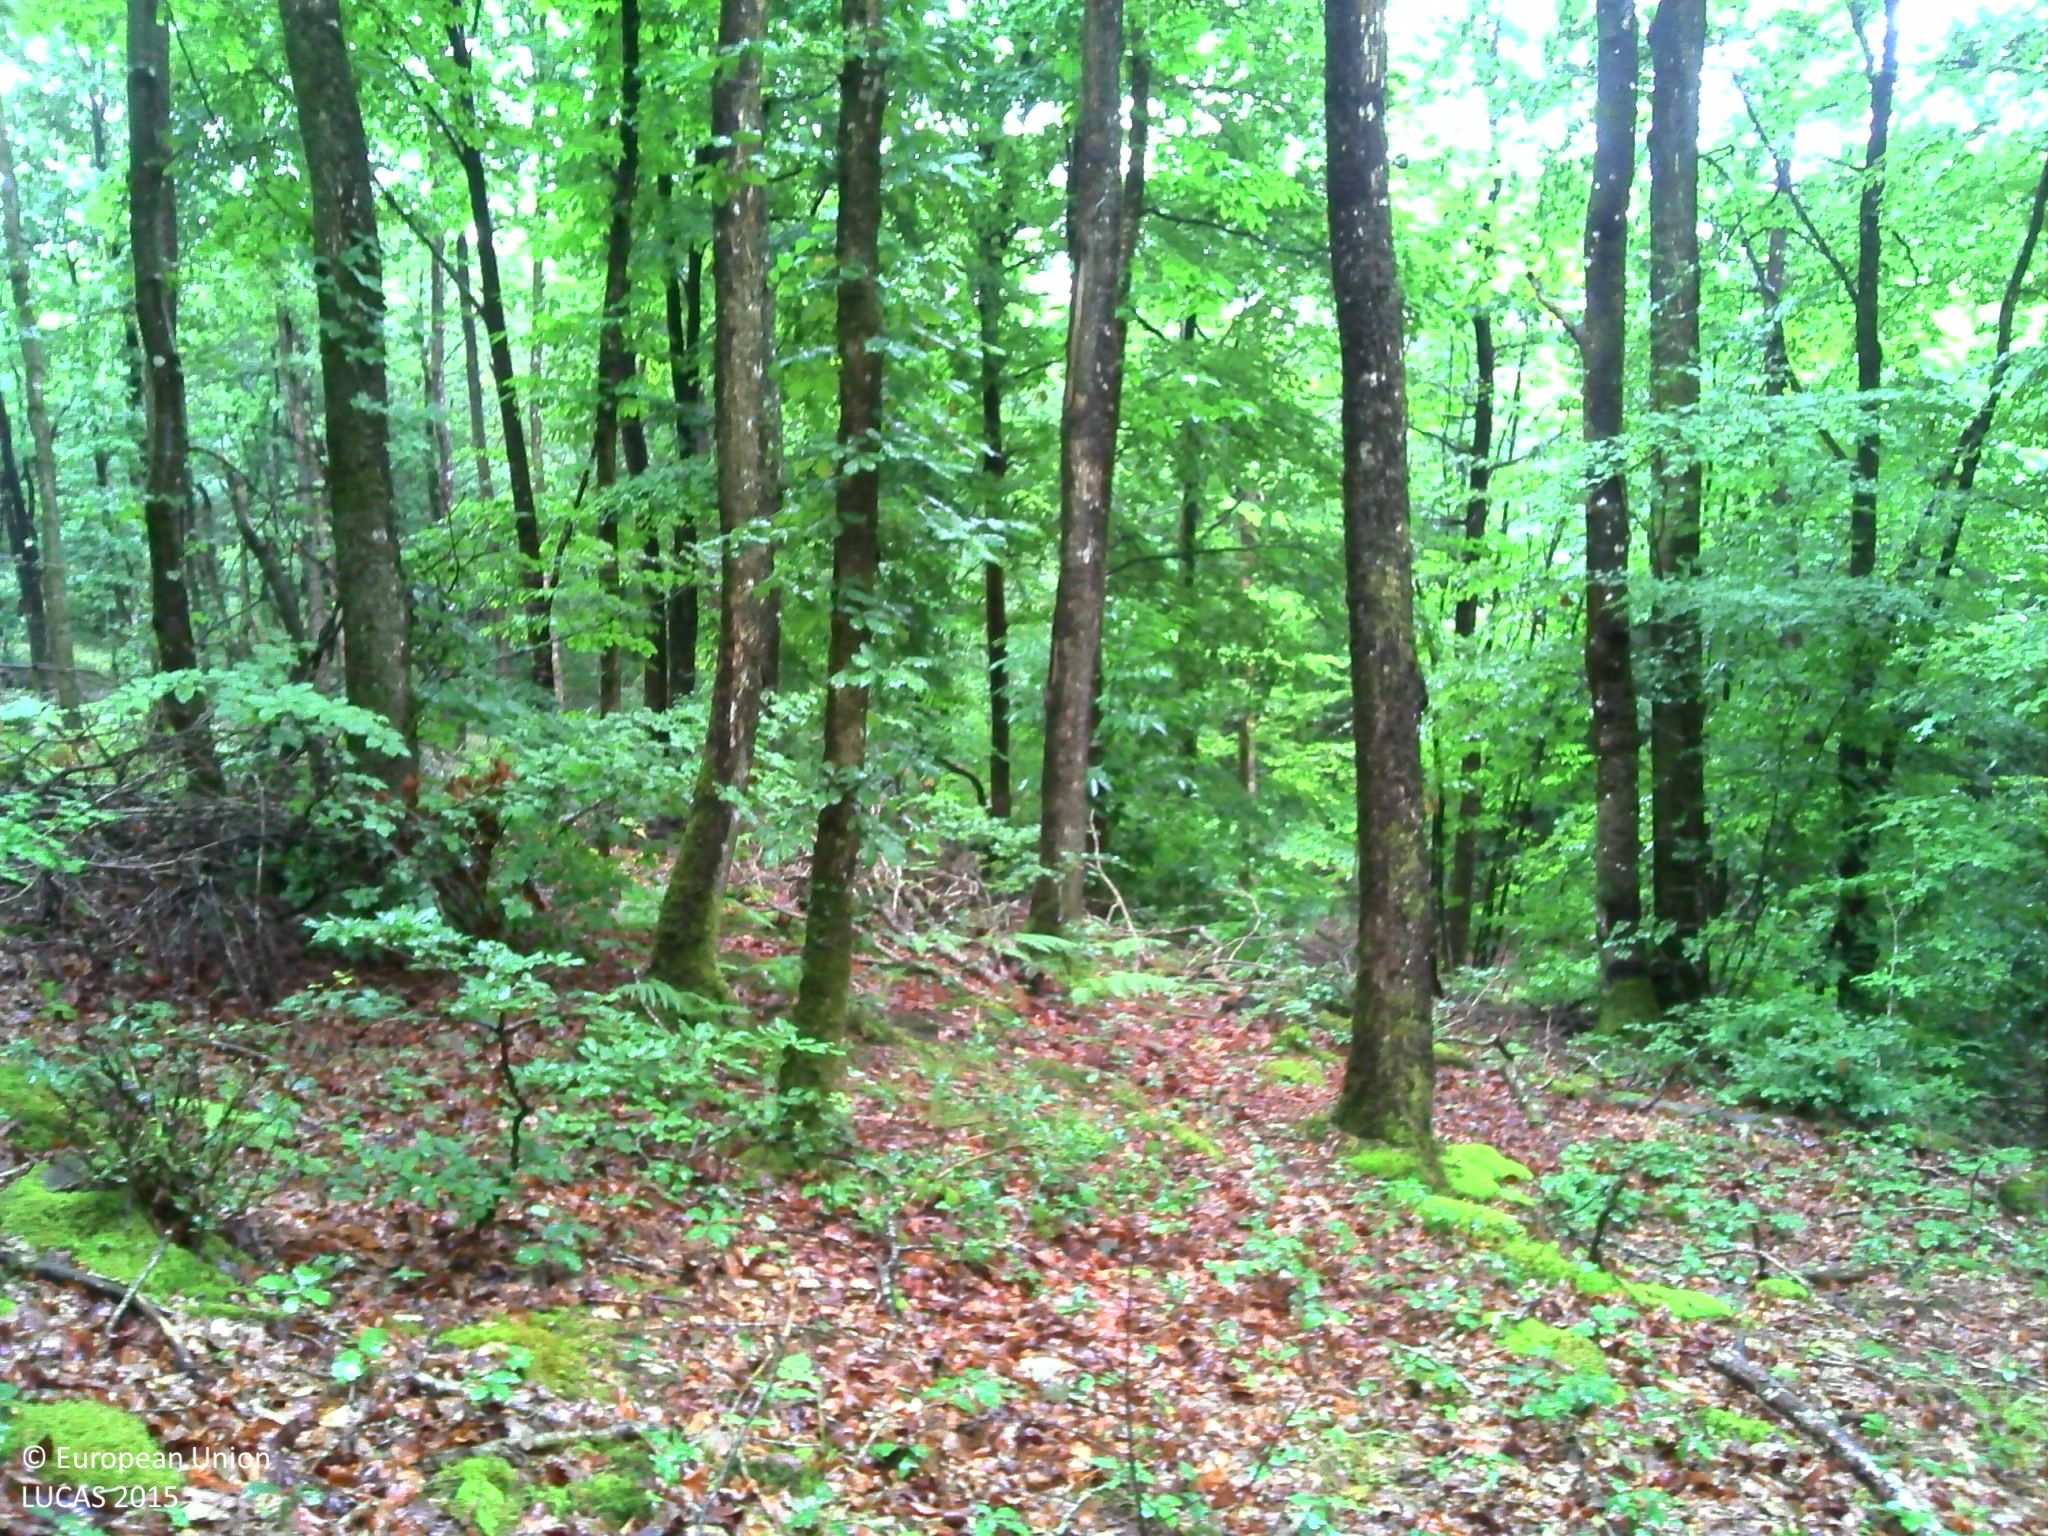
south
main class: Woodland
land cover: Broadleaved woodland
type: acidophilous oak and oak-birch forest
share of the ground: > 75 %
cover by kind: broadleaved forest trees 70 %, lichens and mosses 10 %, consolidated bare surface 10 %, shrubs 5 %, herbaceous plants 5 %
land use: Forestry
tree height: > 5 m
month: July
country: FR
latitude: 47.8051
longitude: -2.9239
